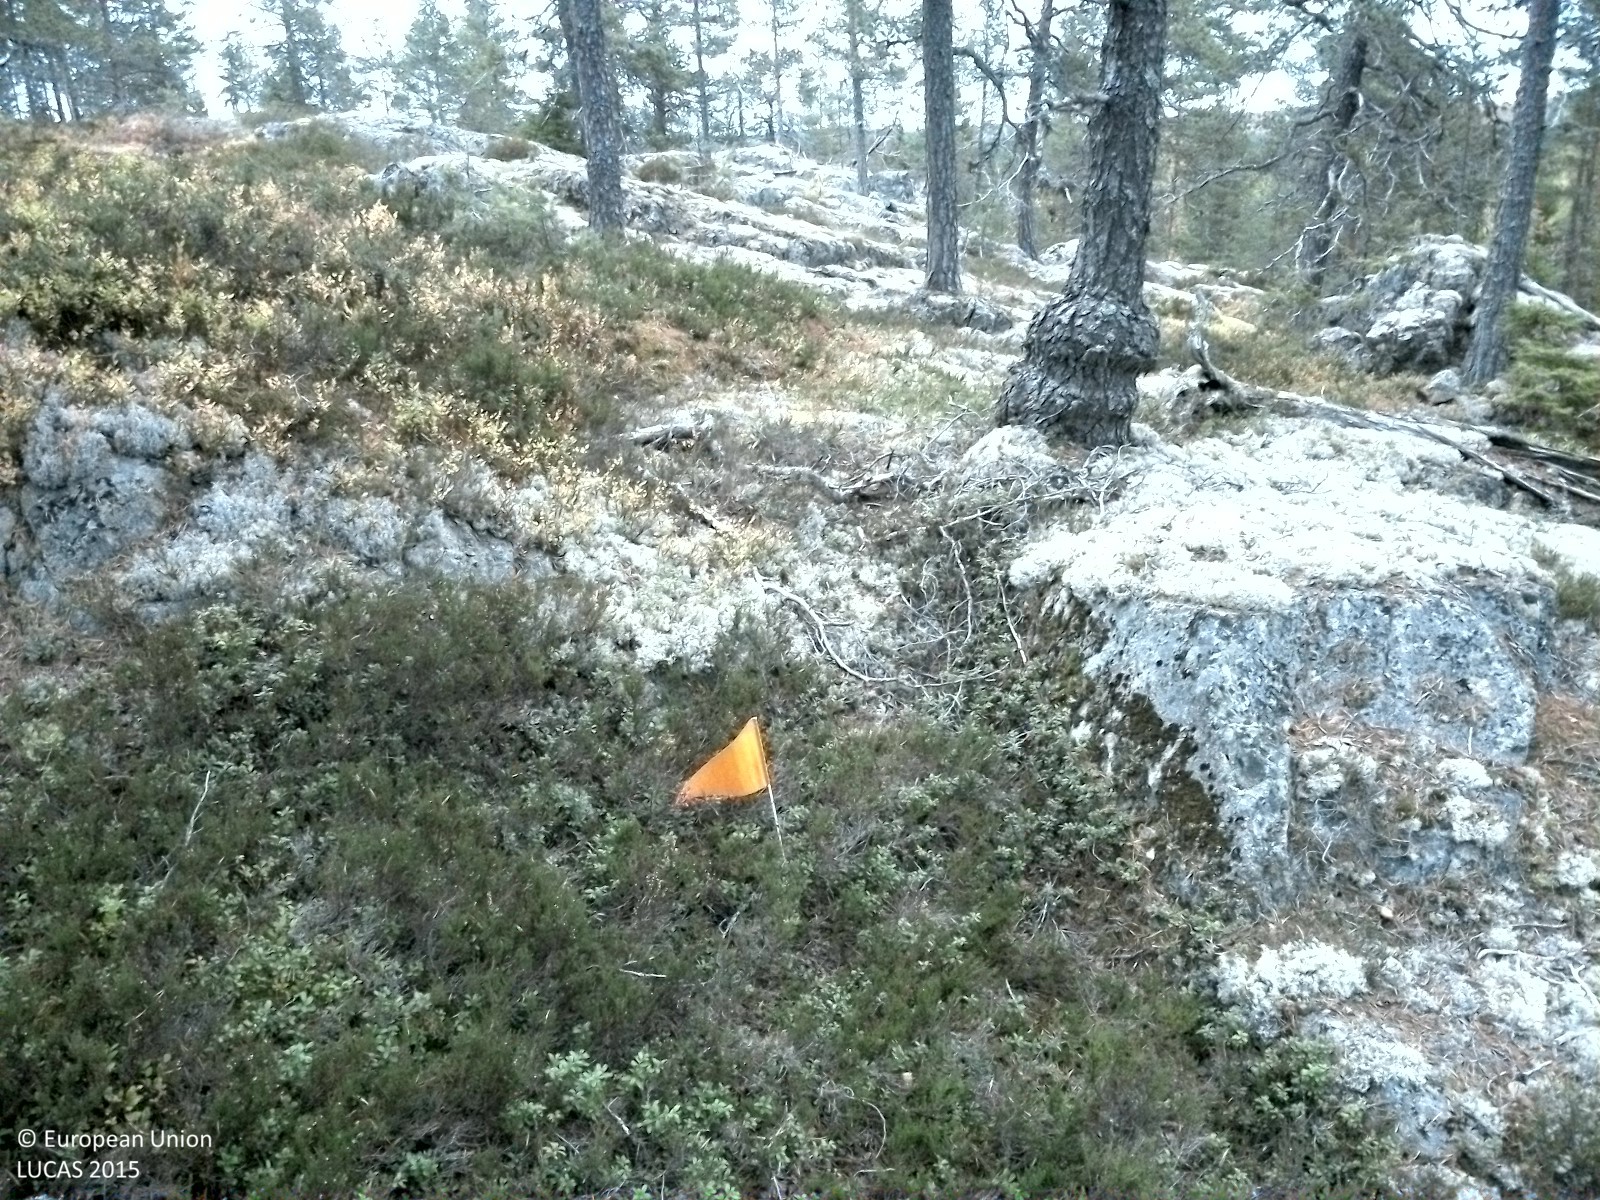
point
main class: Woodland
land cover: Pine dominated coniferous woodland
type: boreal forest
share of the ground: 25 - 50 %
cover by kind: lichens and mosses 40 %, shrubs 30 %, coniferous forest trees 25 %
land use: Forestry
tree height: > 5 m
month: October
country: SE
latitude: 62.5621
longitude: 17.6640
